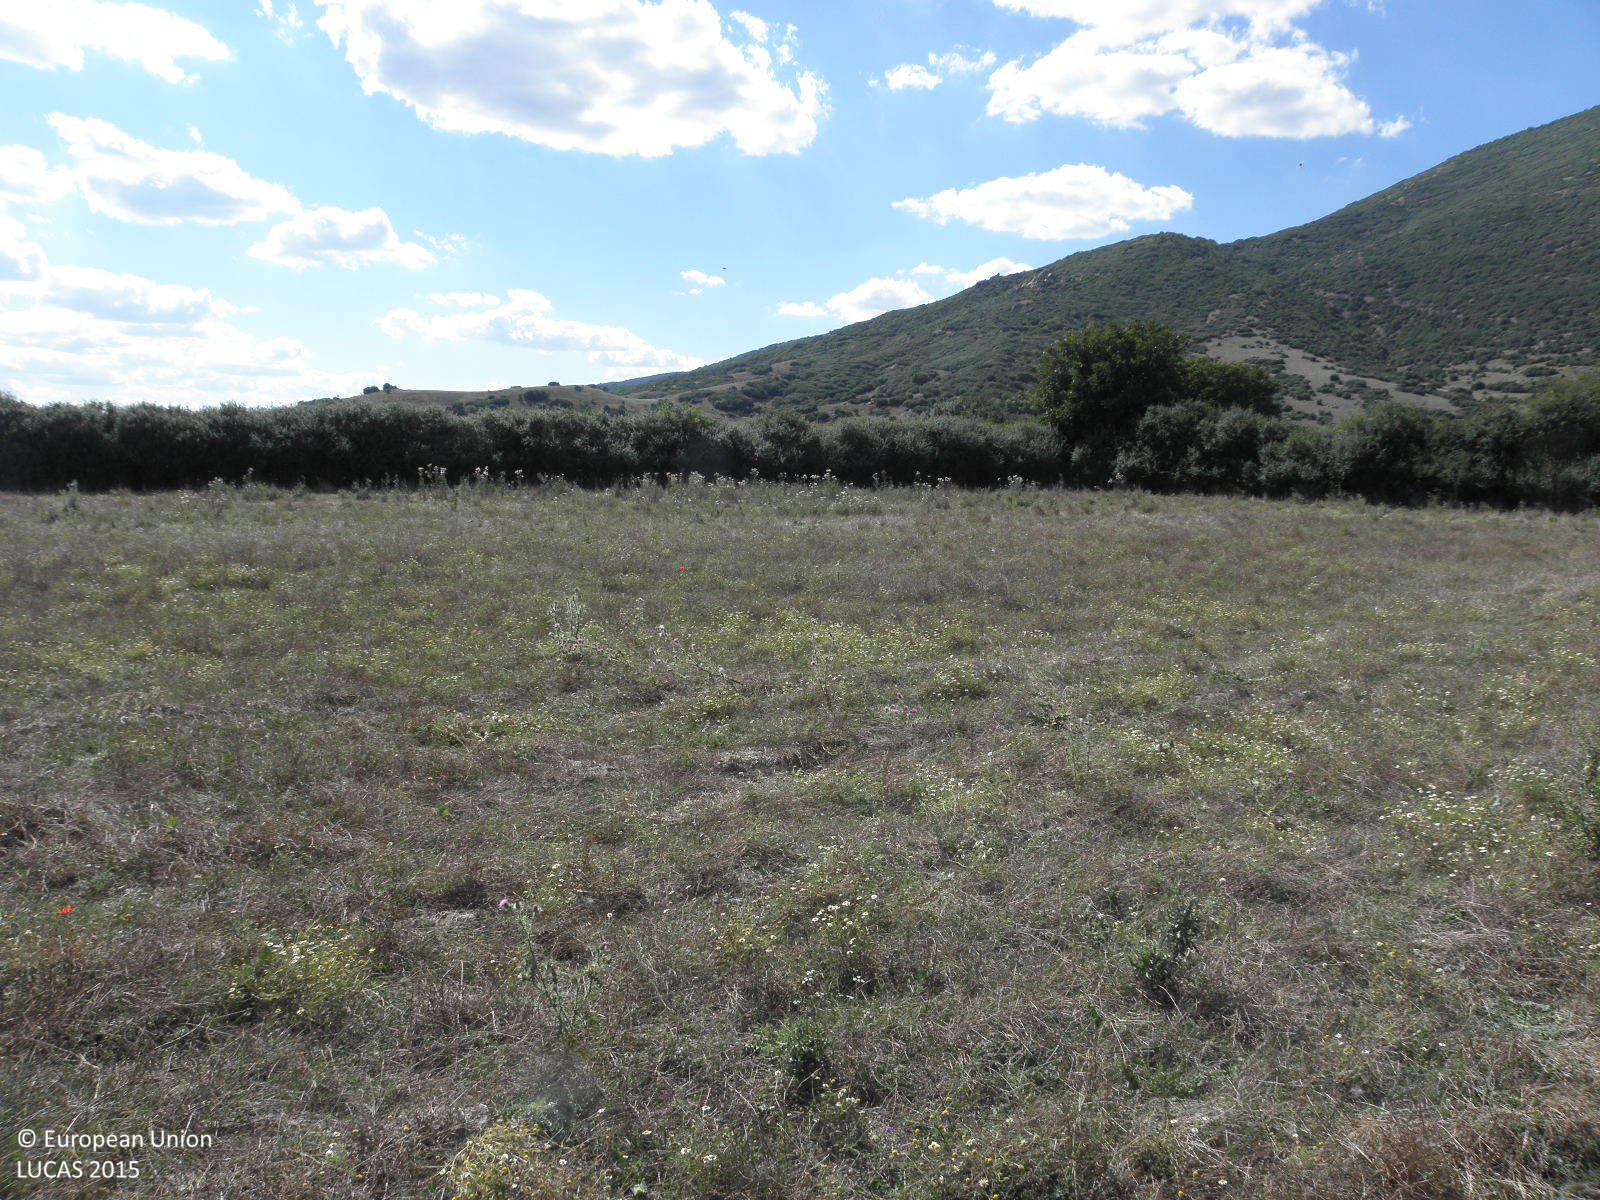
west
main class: Grassland
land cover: Spontaneously vegetated surfaces
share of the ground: > 75 %
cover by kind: herbaceous plants 100 %
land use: Fallow land
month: August
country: GR
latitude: 39.9719
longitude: 22.3928
